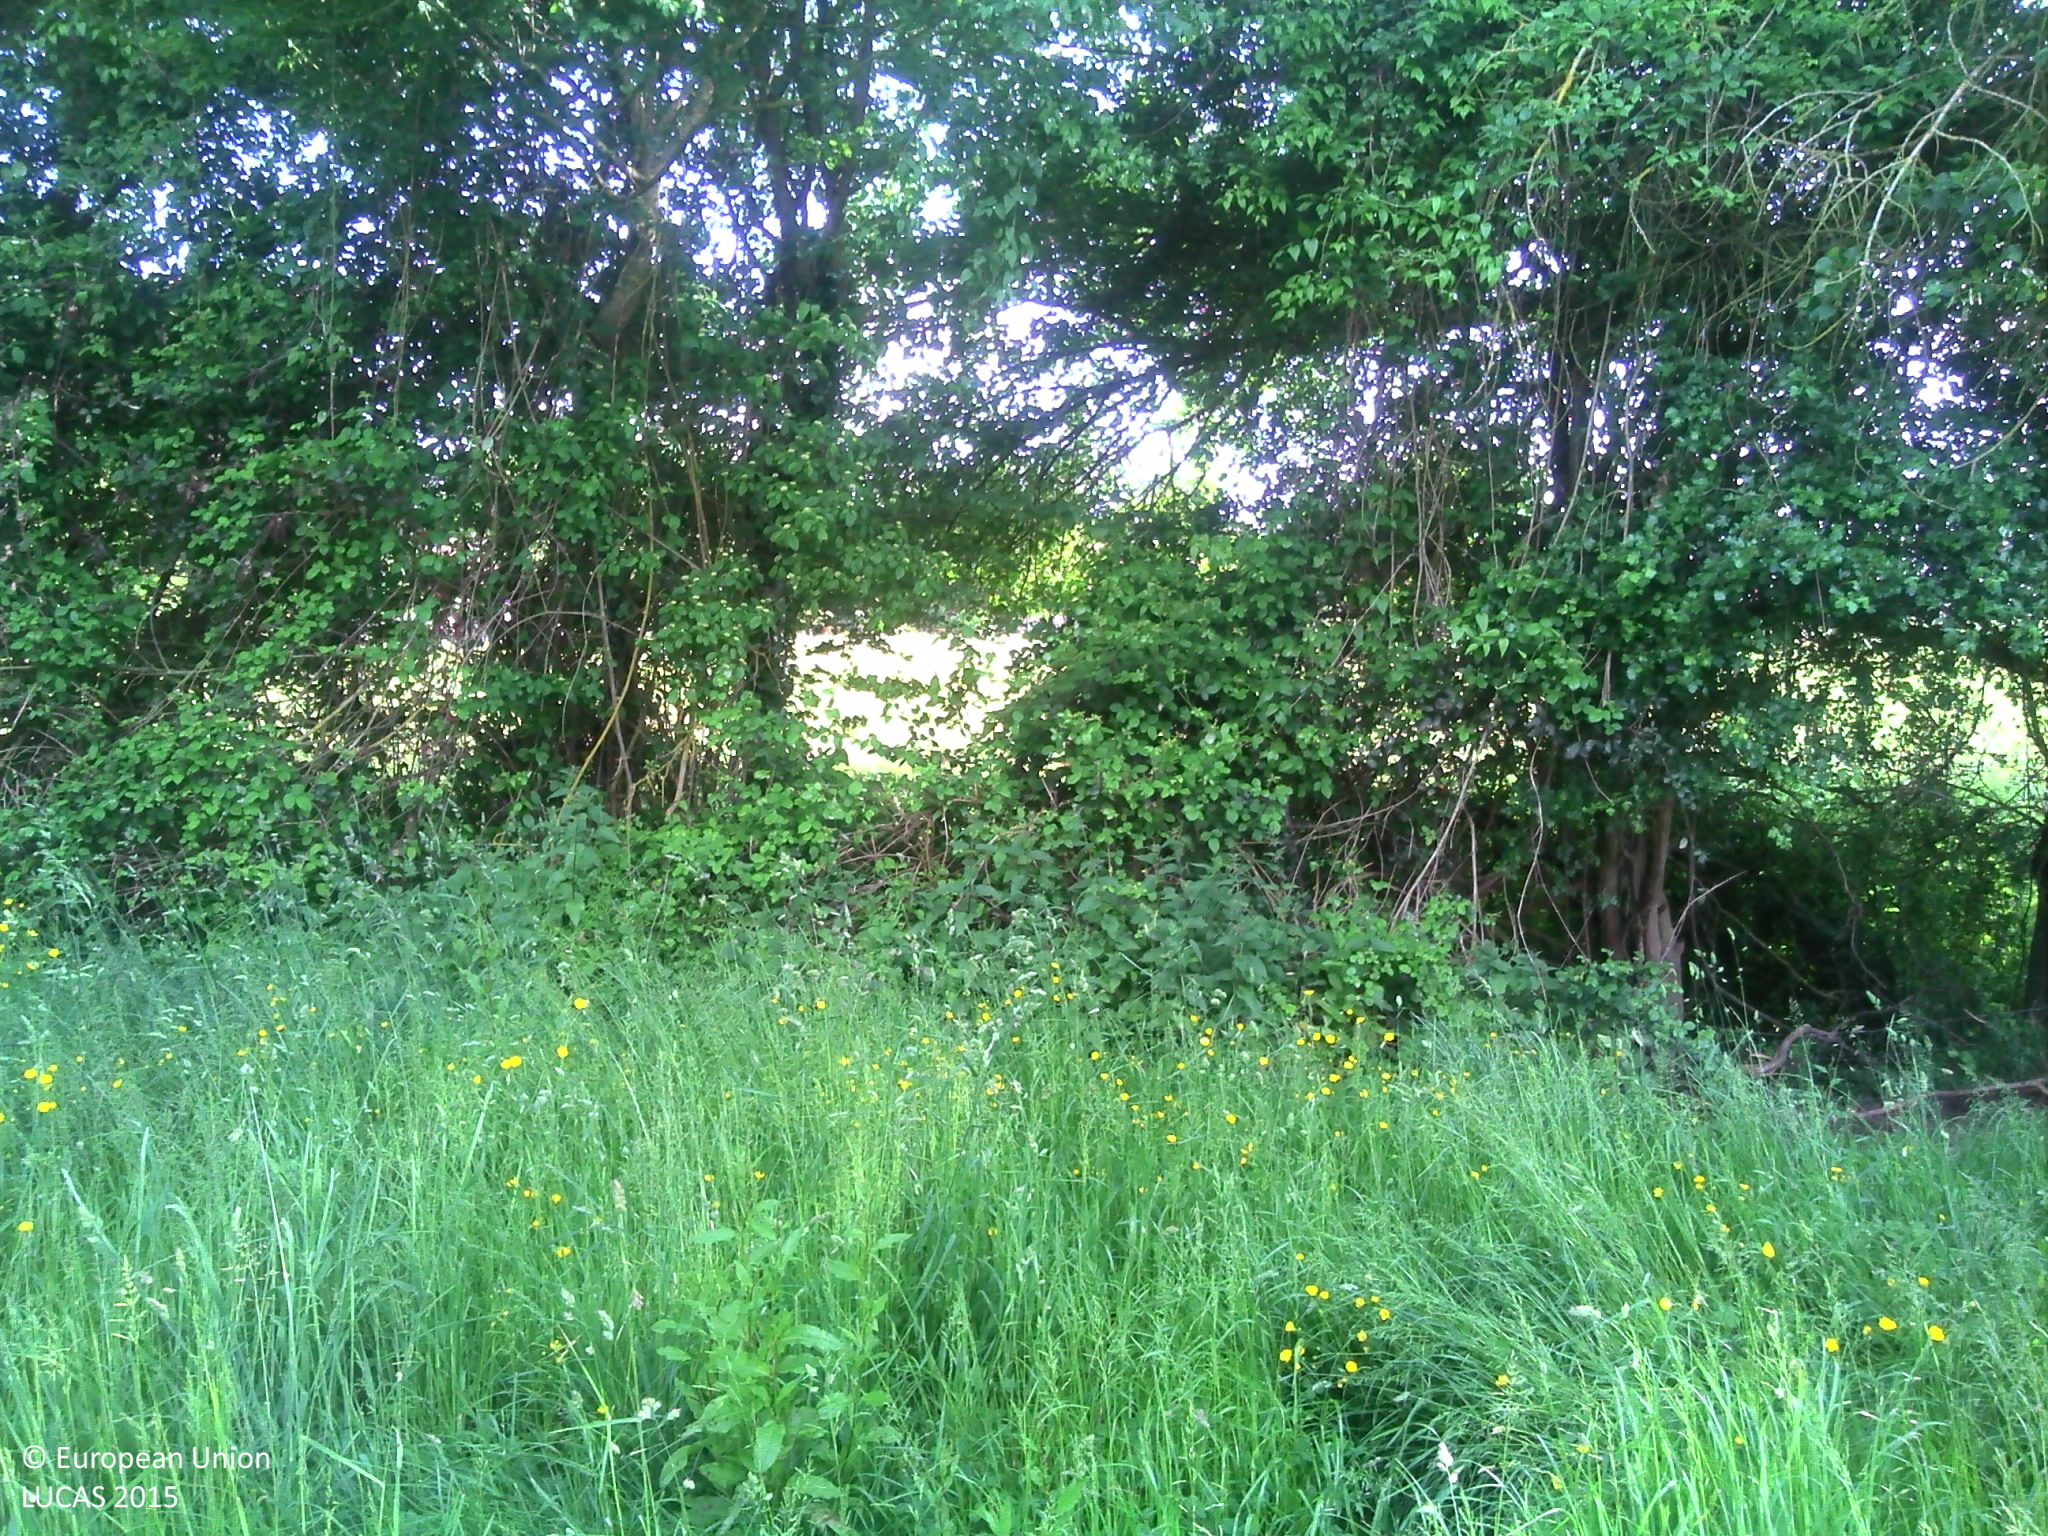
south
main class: Grassland
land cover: Grassland without tree/shrub cover
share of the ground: > 75 %
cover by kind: herbaceous plants 100 %
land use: Agriculture (excluding fallow land and kitchen gardens)
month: June
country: FR
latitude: 48.8301
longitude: 0.1218
